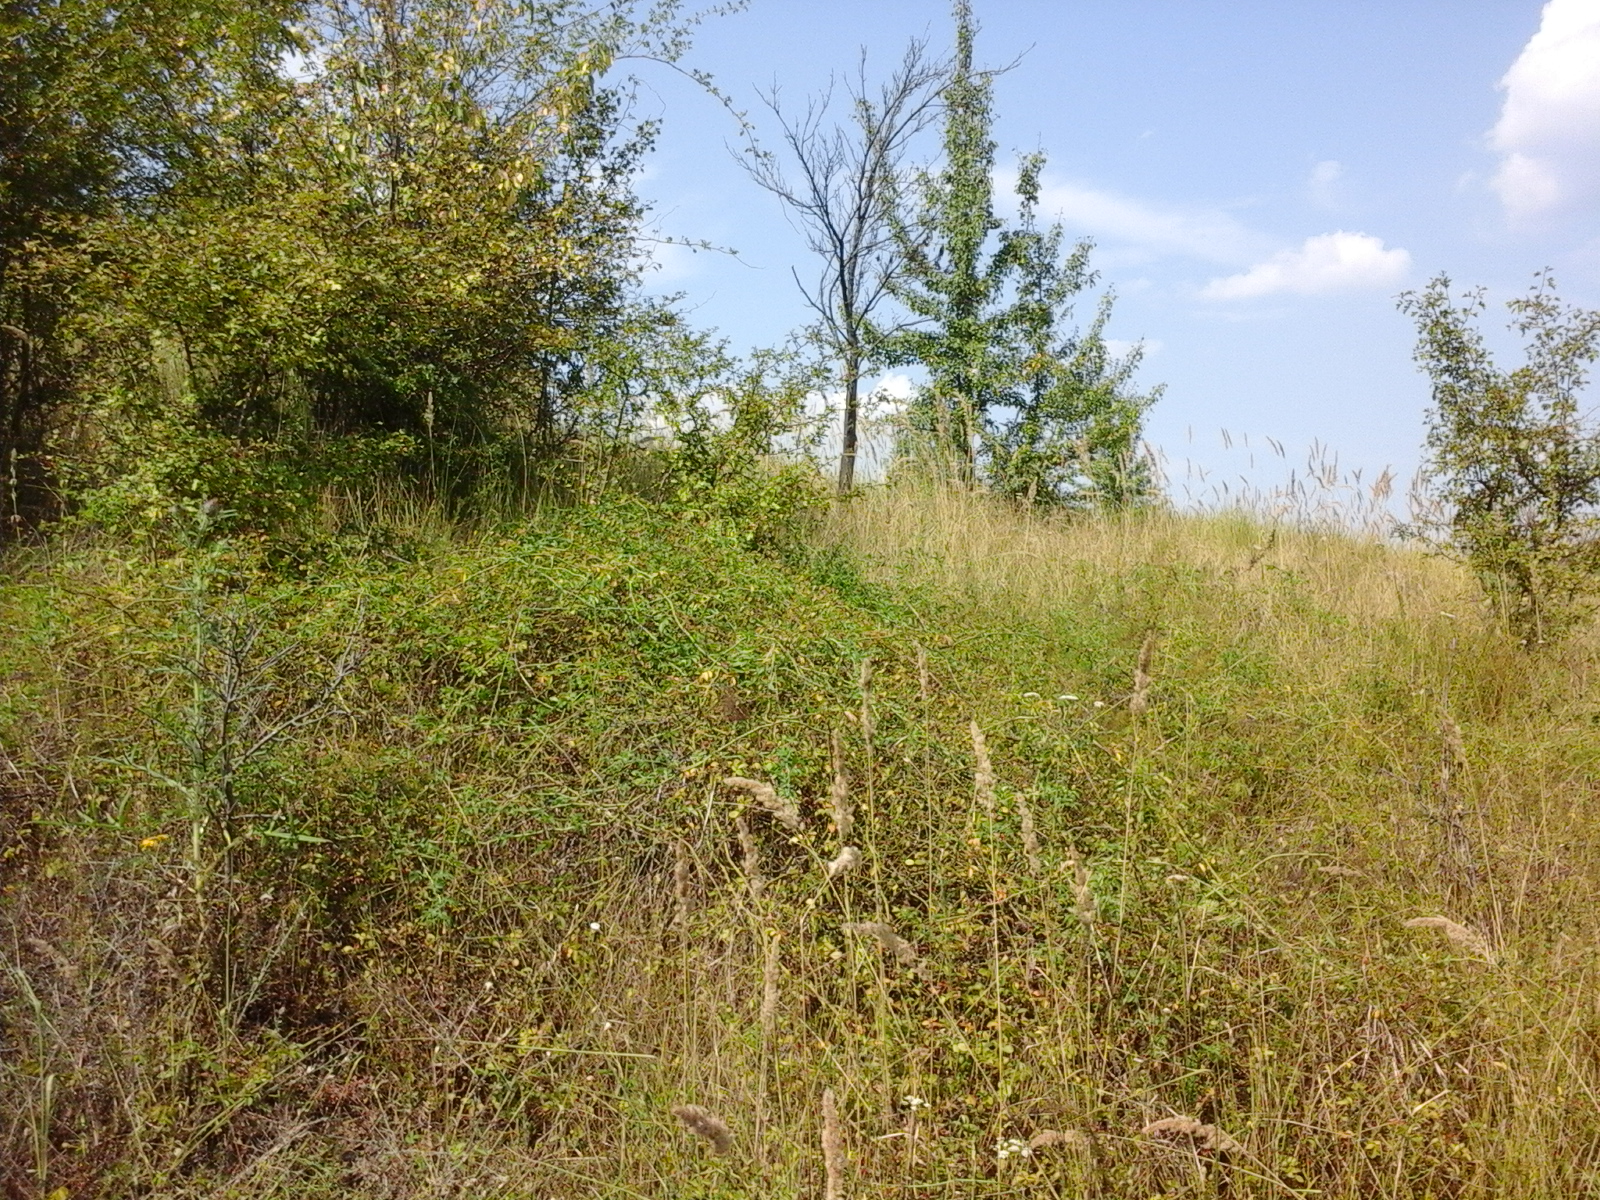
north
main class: Grassland
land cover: Grassland with sparse tree/shrub cover
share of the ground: > 75 %
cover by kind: herbaceous plants 95 %, broadleaved forest trees 5 %
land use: Agriculture (excluding fallow land and kitchen gardens)
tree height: < 5 m
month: August
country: RO
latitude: 44.8545
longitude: 23.8936
